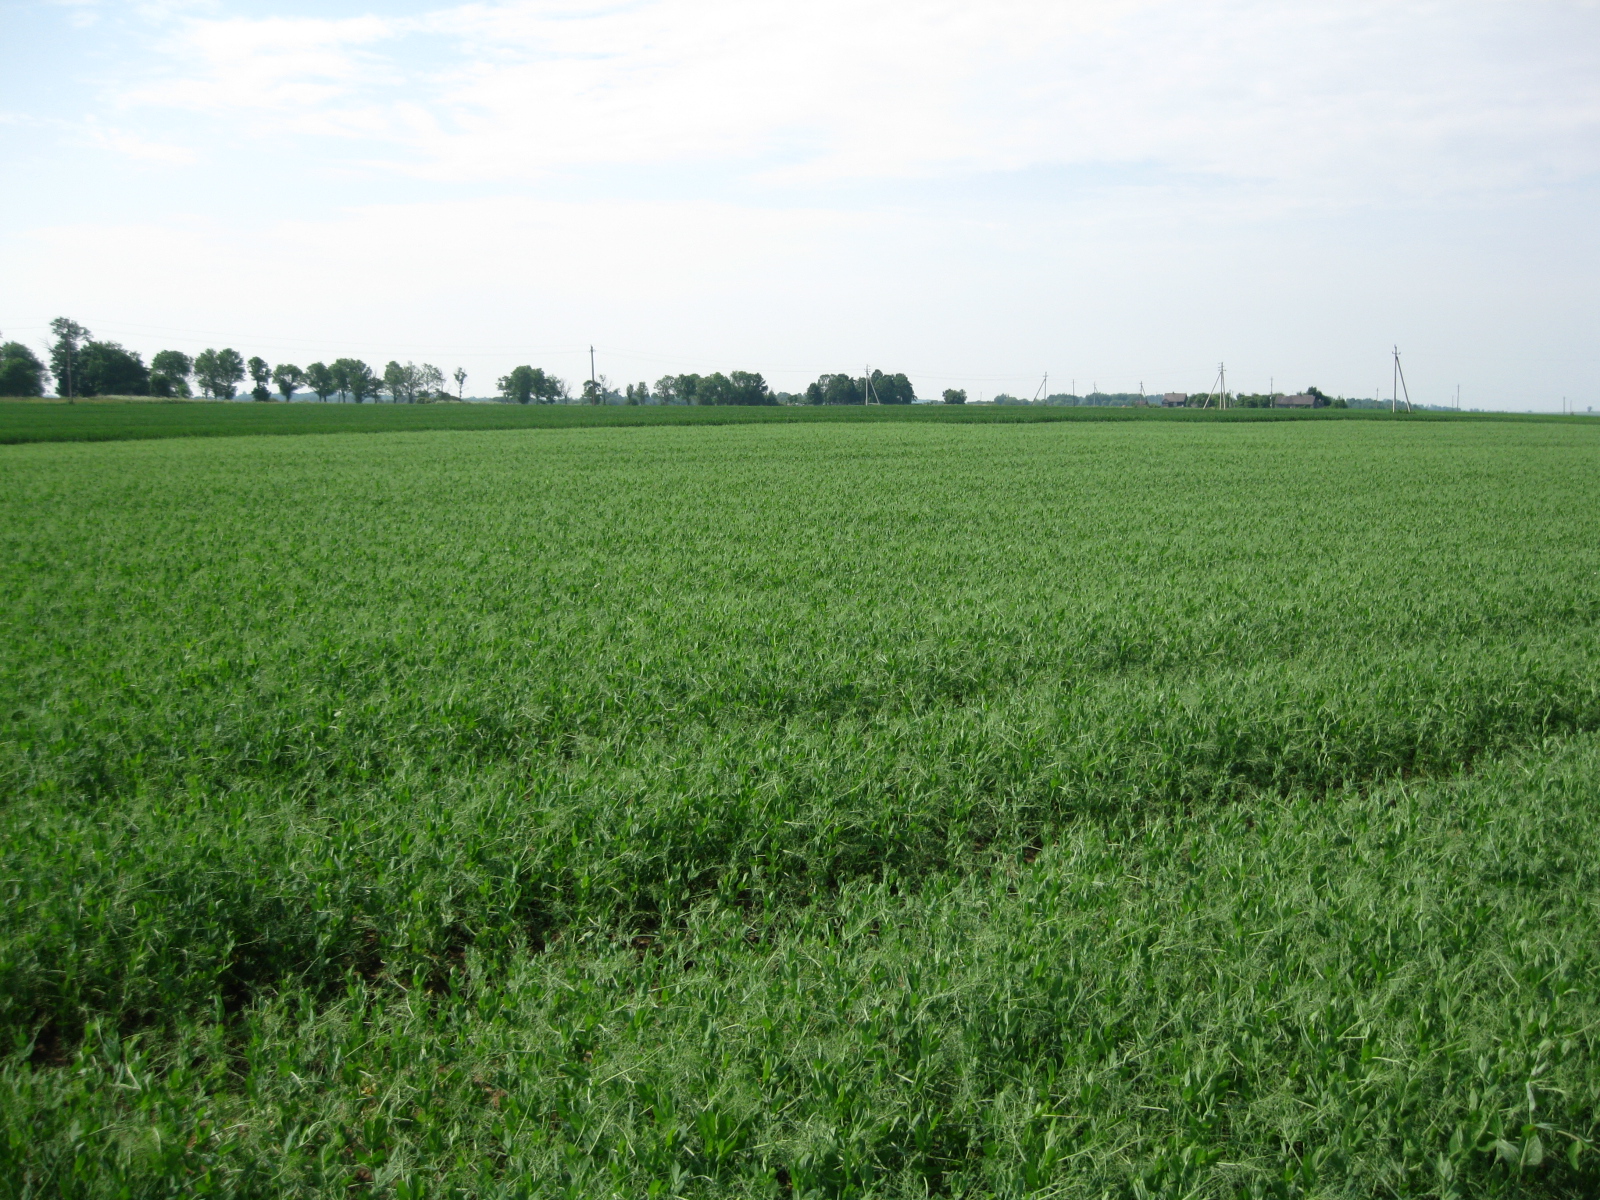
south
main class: Cropland
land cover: Dry pulses
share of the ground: > 75 %
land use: Agriculture (excluding fallow land and kitchen gardens)
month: June
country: LT
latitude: 55.3809
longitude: 23.4788
